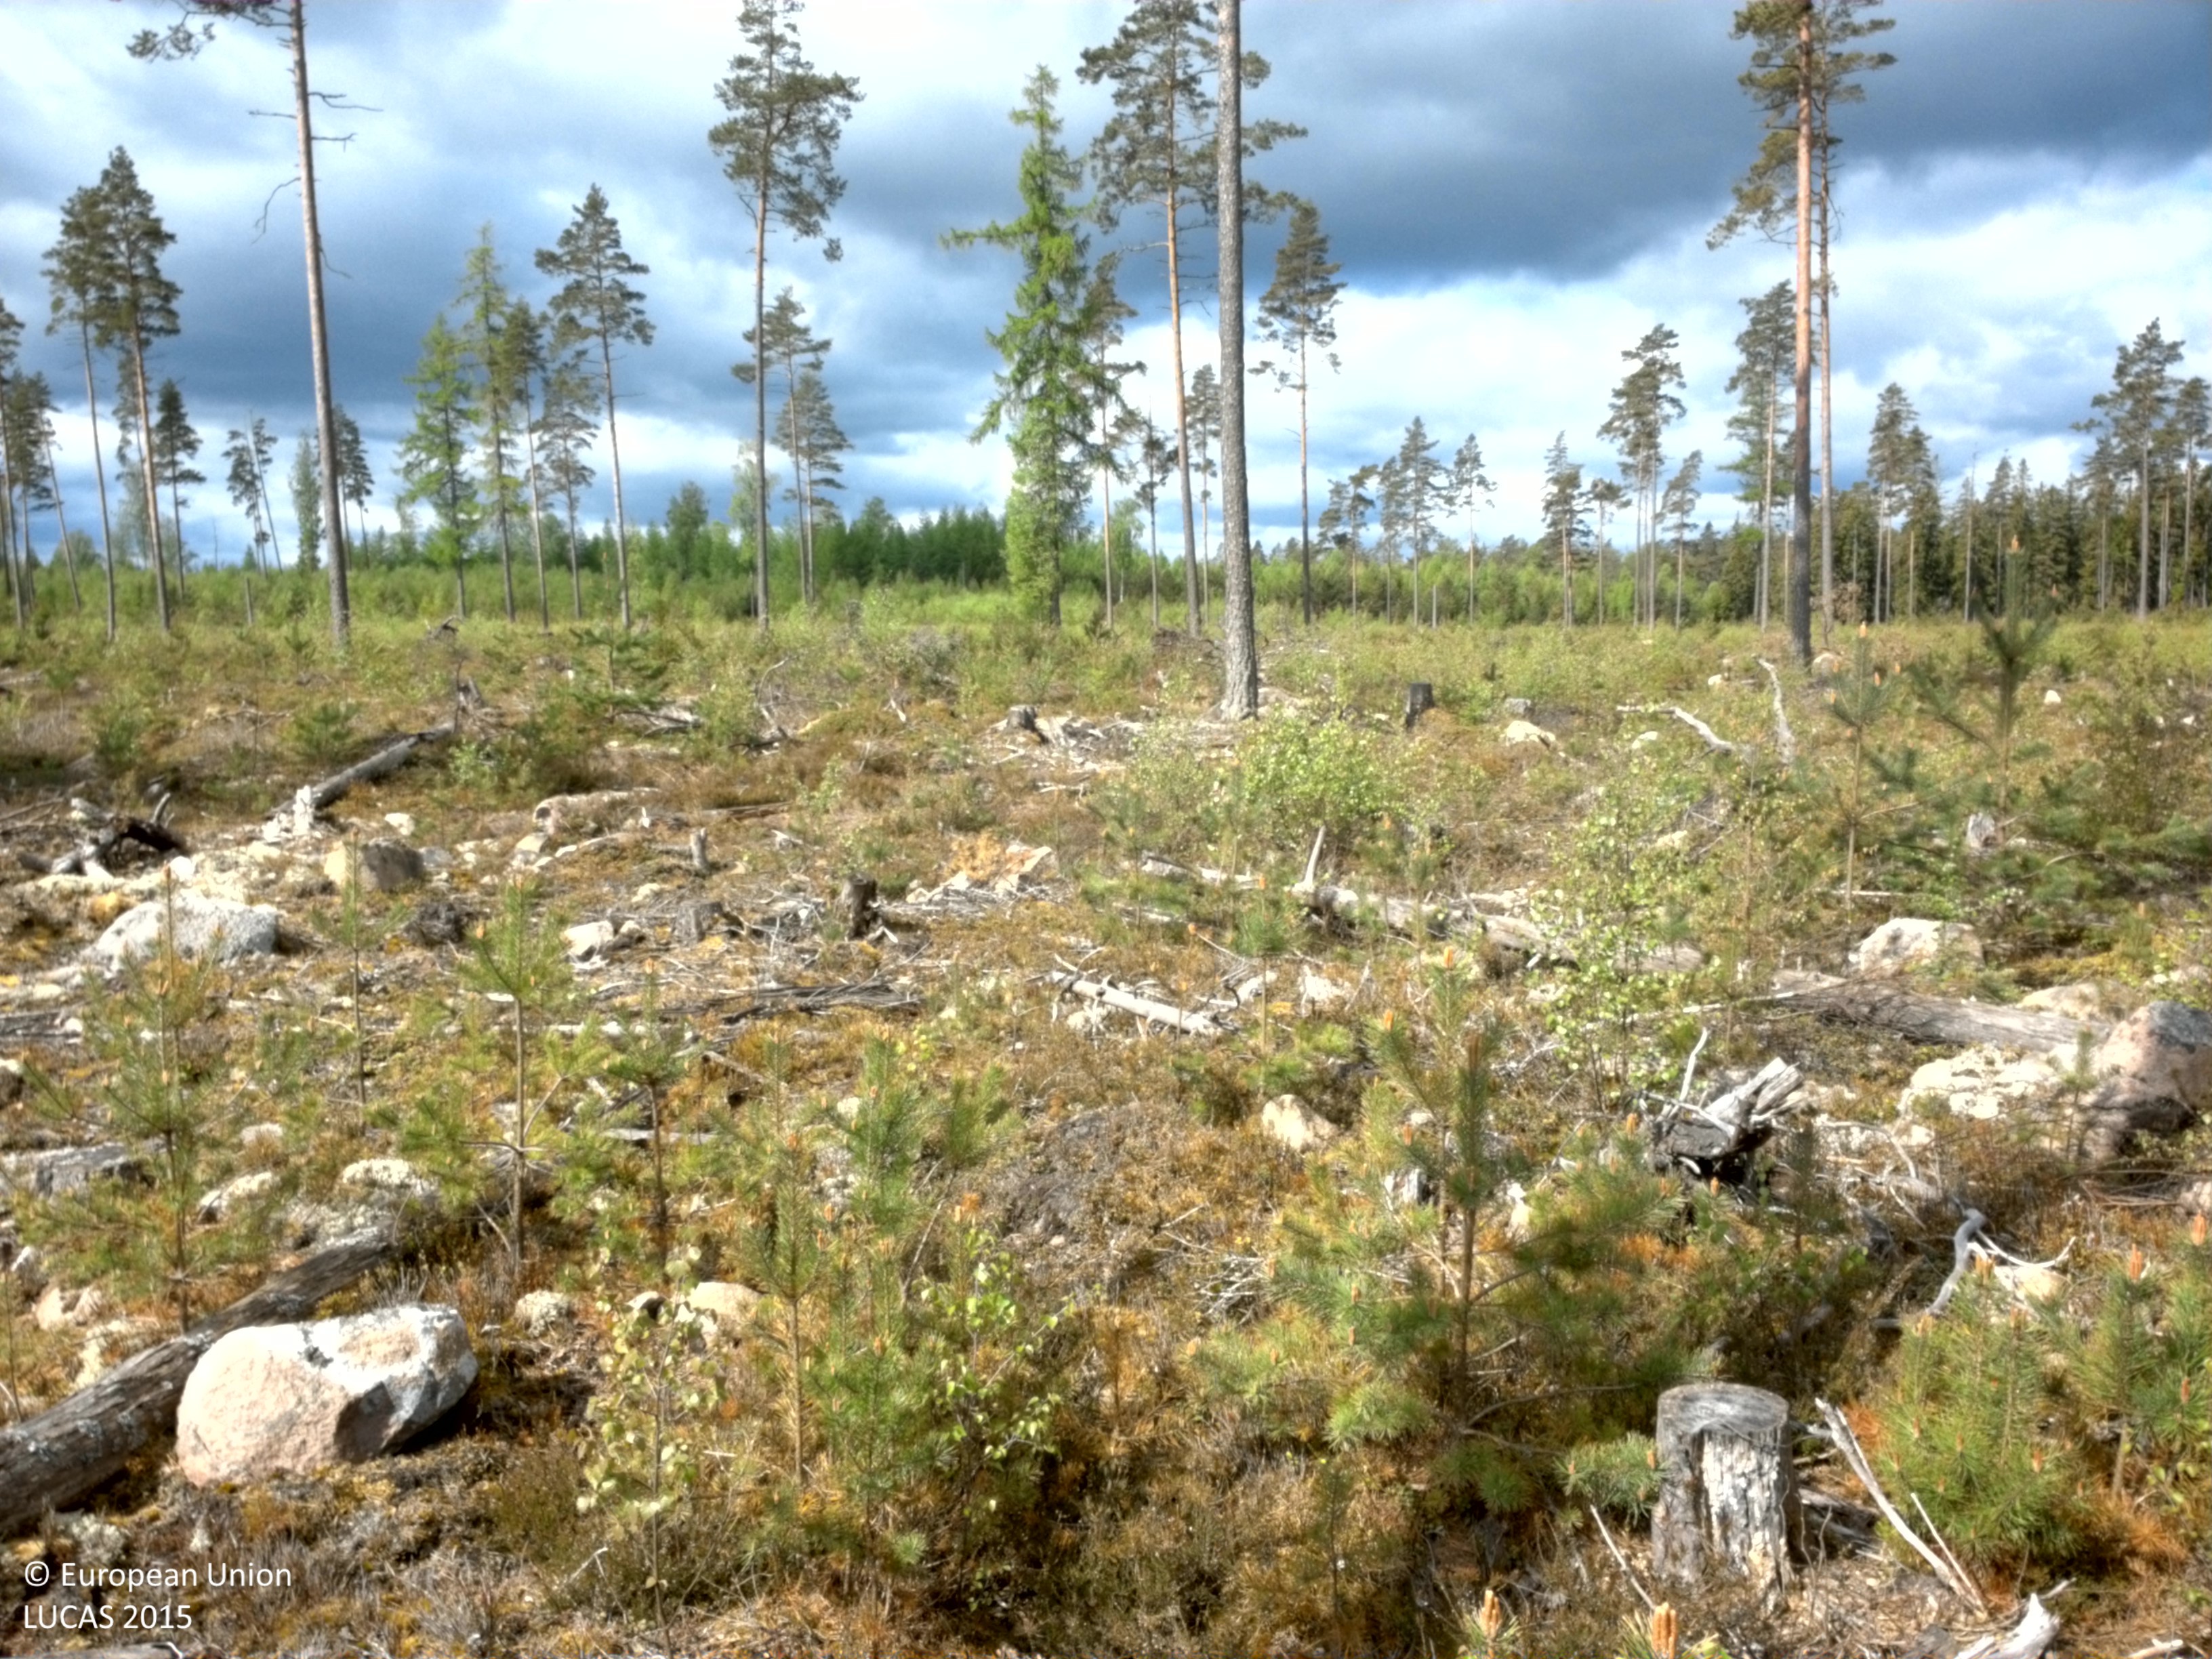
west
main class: Woodland
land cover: Pine dominated coniferous woodland
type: boreal forest
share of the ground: 25 - 50 %
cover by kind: coniferous forest trees 40 %, shrubs 20 %, broadleaved forest trees 10 %, lichens and mosses 10 %
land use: Forestry
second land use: Amenities, museums, leisure
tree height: > 5 m
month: May
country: SE
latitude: 56.7625
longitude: 15.3147
